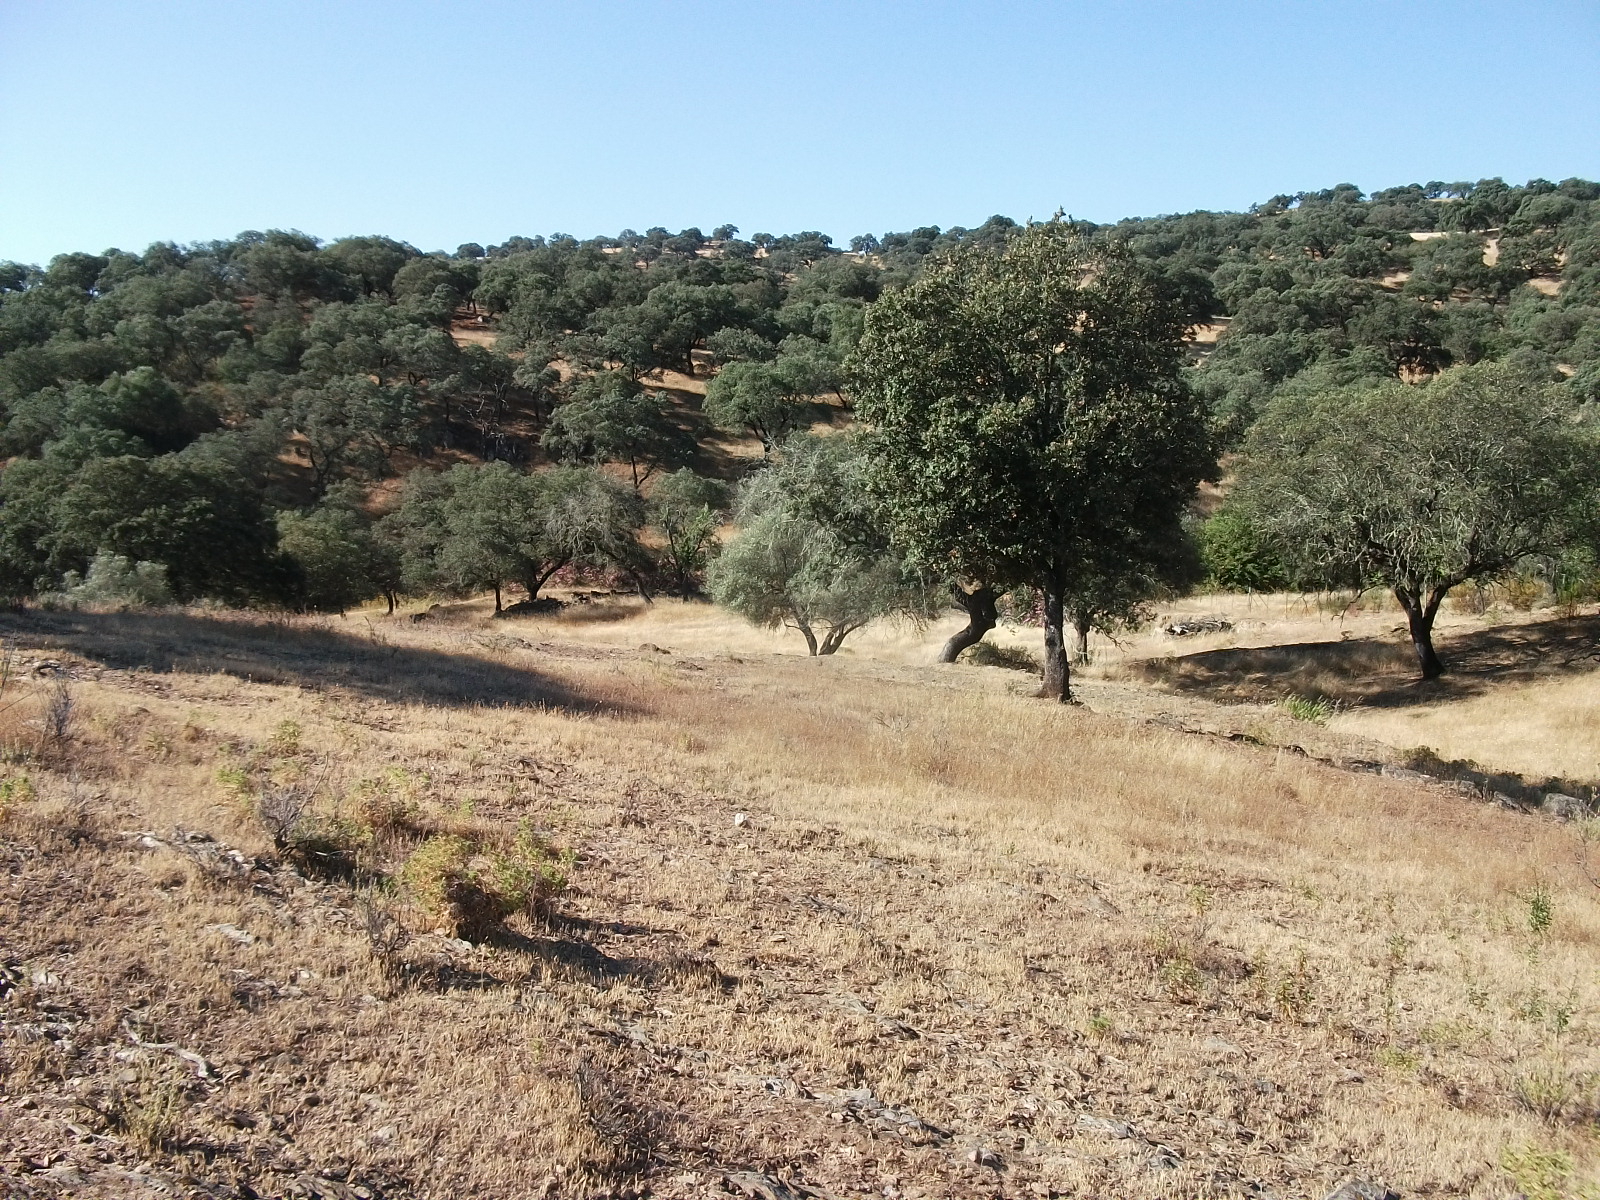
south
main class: Grassland
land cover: Grassland with sparse tree/shrub cover
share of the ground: > 75 %
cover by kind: herbaceous plants 95 %, broadleaved forest trees 5 %
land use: Agriculture (excluding fallow land and kitchen gardens)
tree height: < 5 m
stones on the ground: > 50 %
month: June
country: ES
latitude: 37.6392
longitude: -7.0352
